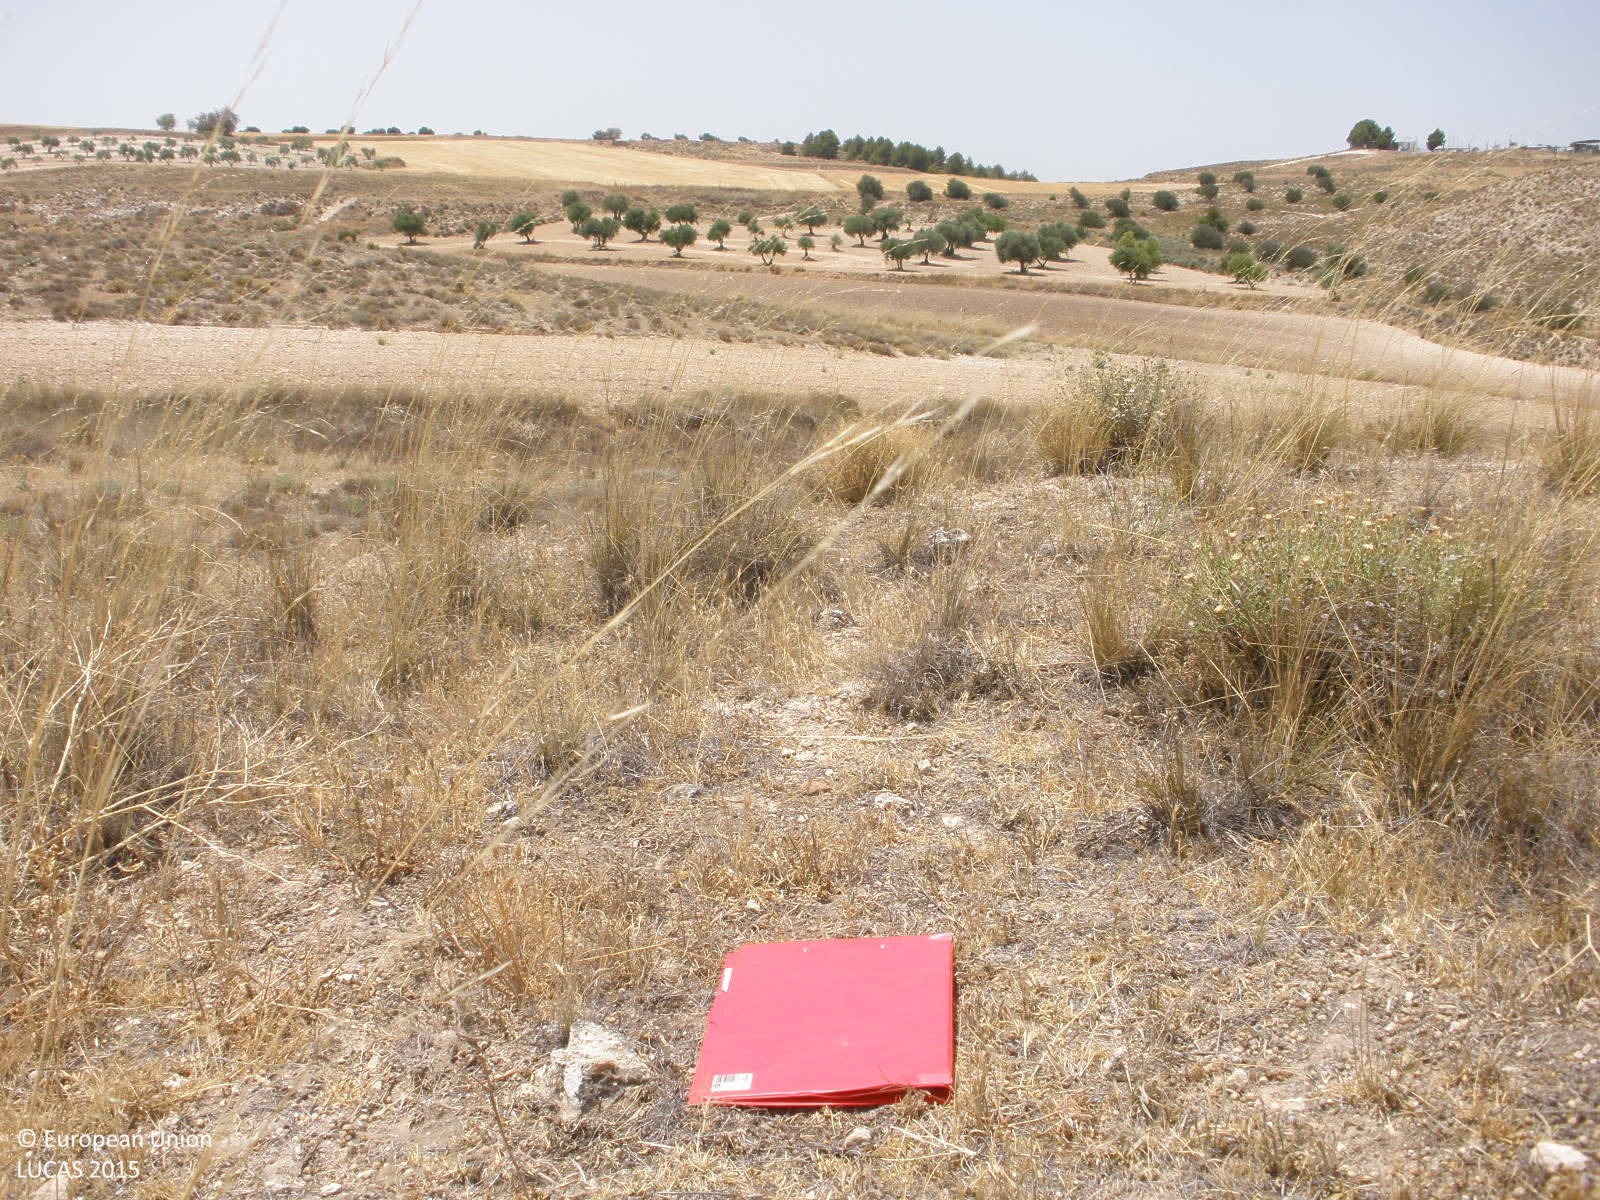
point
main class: Shrubland
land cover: Shrubland without tree cover
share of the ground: 25 - 50 %
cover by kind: herbaceous plants 70 %, shrubs 30 %
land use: Semi-natural and natural areas not in use
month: July
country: ES
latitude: 39.9964
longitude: -3.1789
